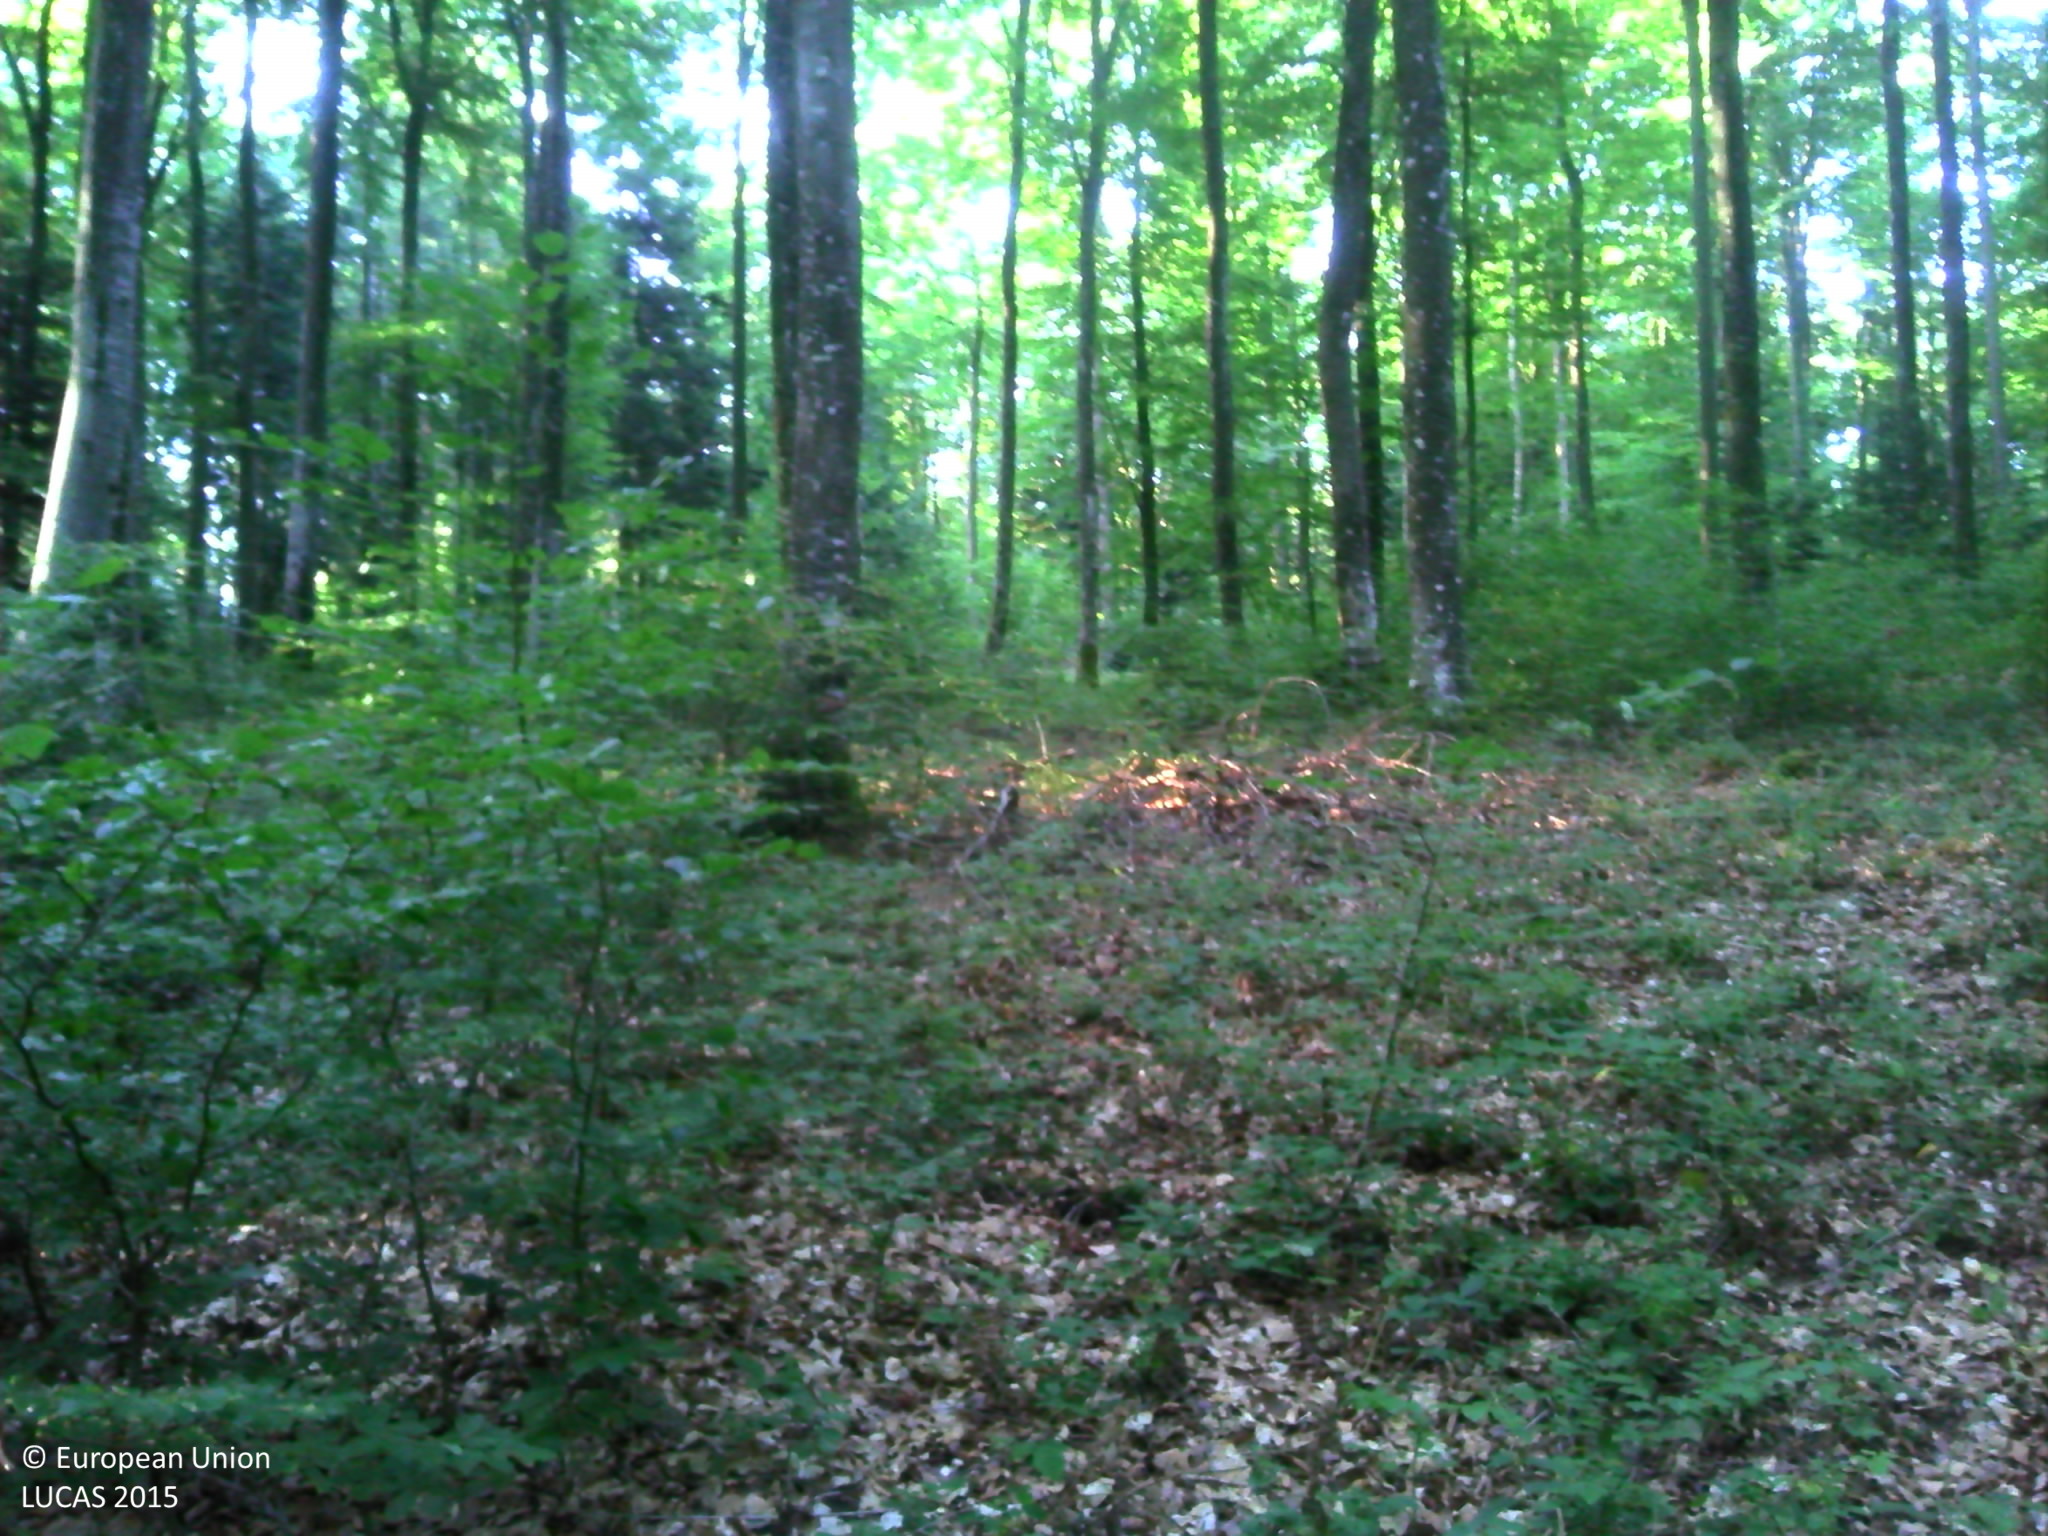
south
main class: Woodland
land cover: Broadleaved woodland
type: beech forest
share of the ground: > 75 %
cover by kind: broadleaved forest trees 75 %, herbaceous plants 25 %
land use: Forestry
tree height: > 5 m
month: August
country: FR
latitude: 46.8709
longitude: 4.3719
